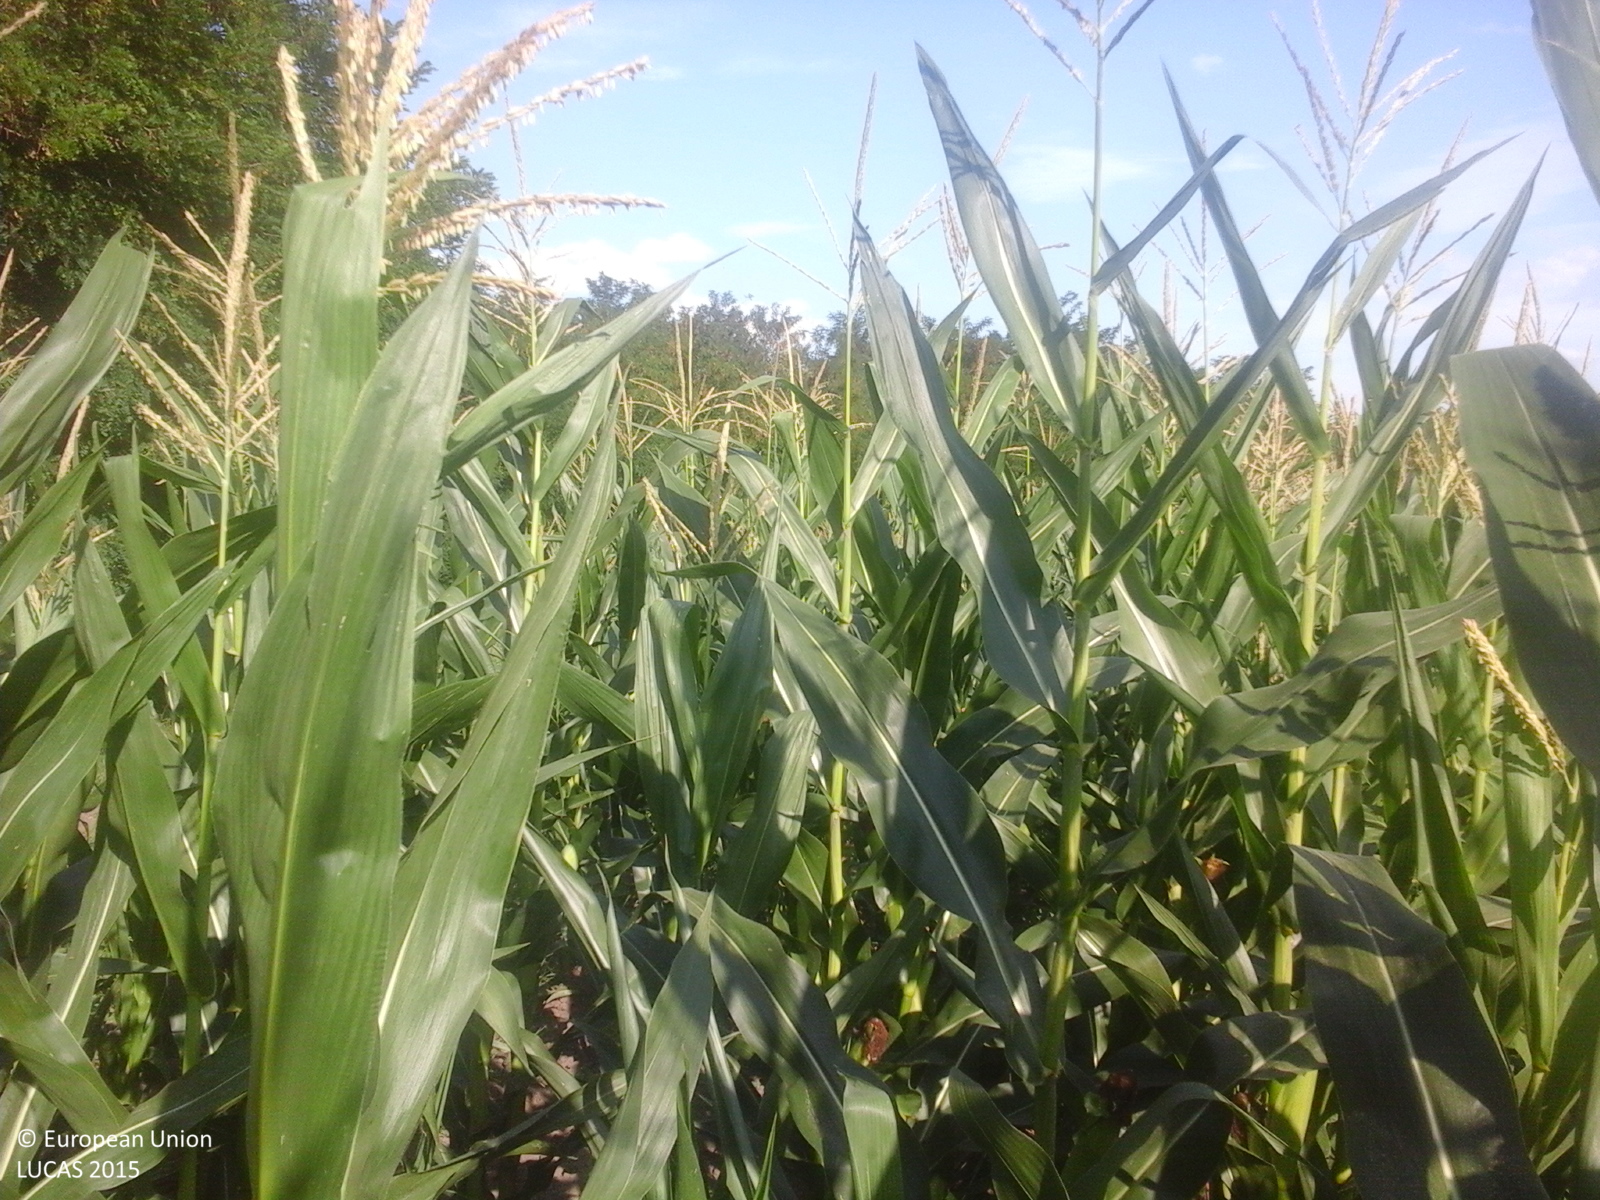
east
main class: Cropland
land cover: Maize
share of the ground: > 75 %
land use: Agriculture (excluding fallow land and kitchen gardens)
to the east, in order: Maize
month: July
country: RO
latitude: 46.4356
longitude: 27.9683
